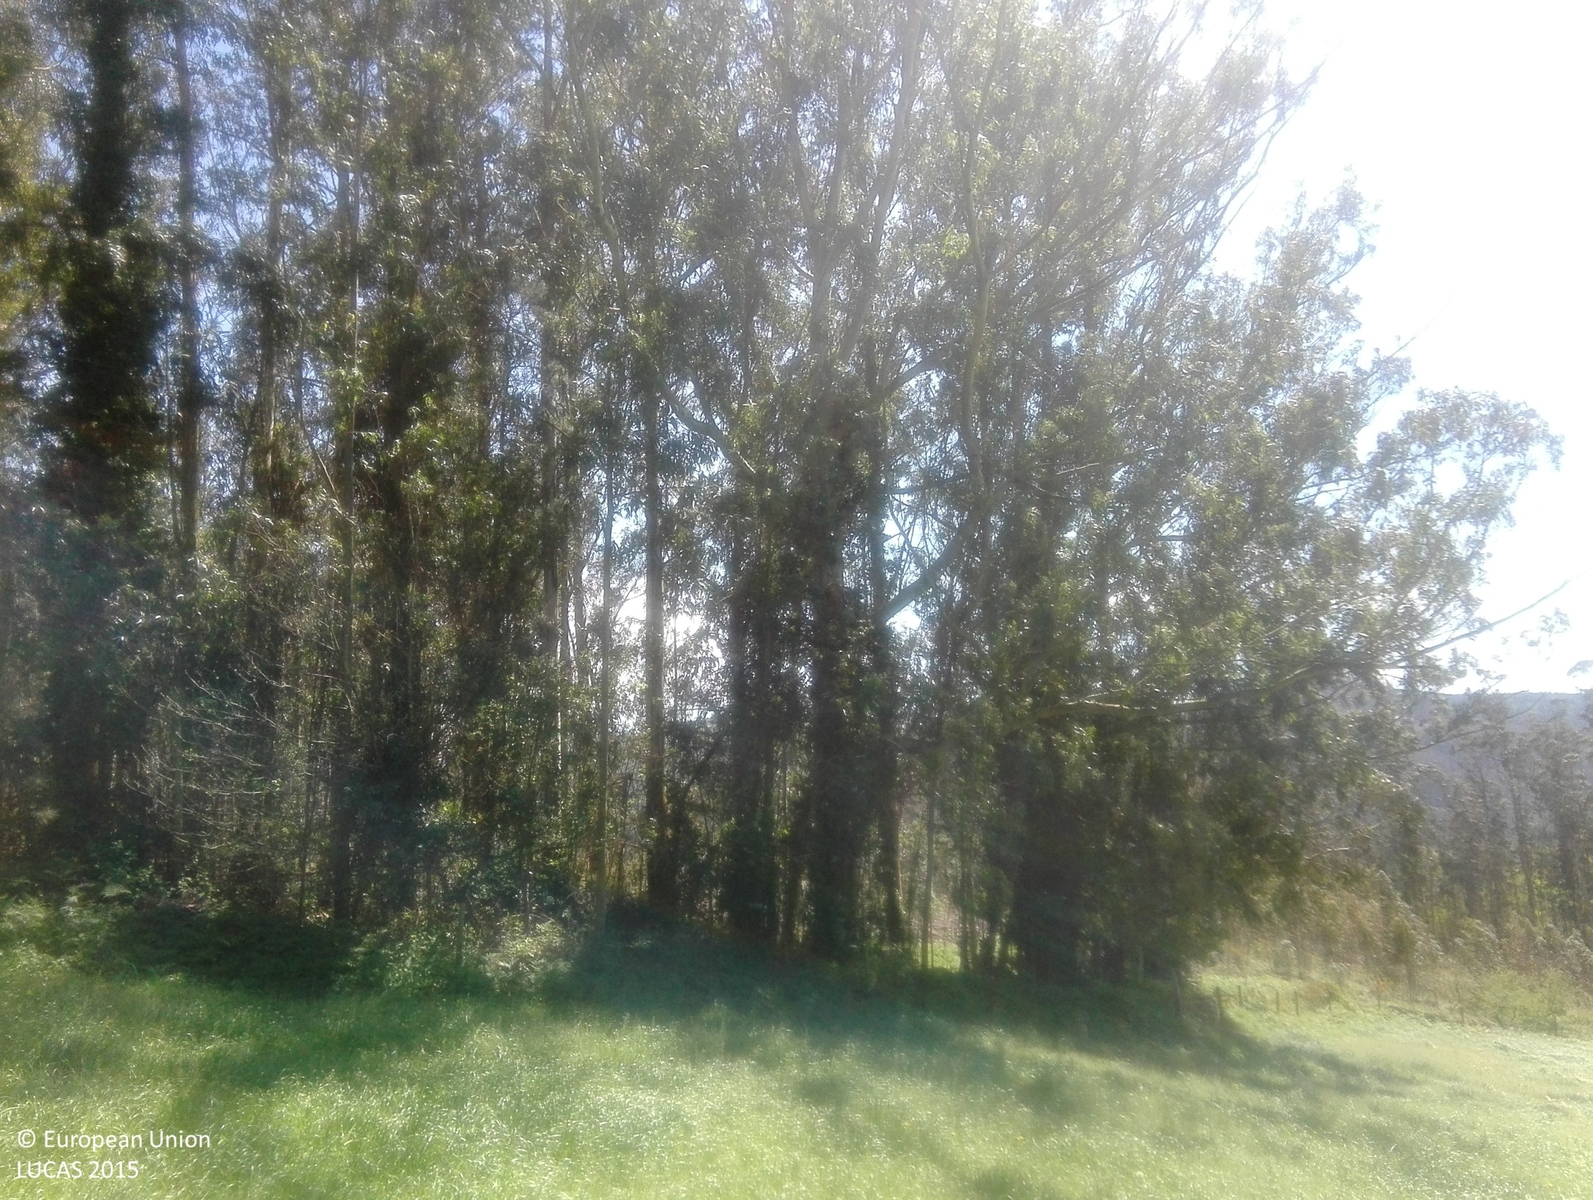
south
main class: Cropland
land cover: Temporary grasslands
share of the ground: > 75 %
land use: Agriculture (excluding fallow land and kitchen gardens)
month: April
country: ES
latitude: 43.4759
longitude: -7.0680
